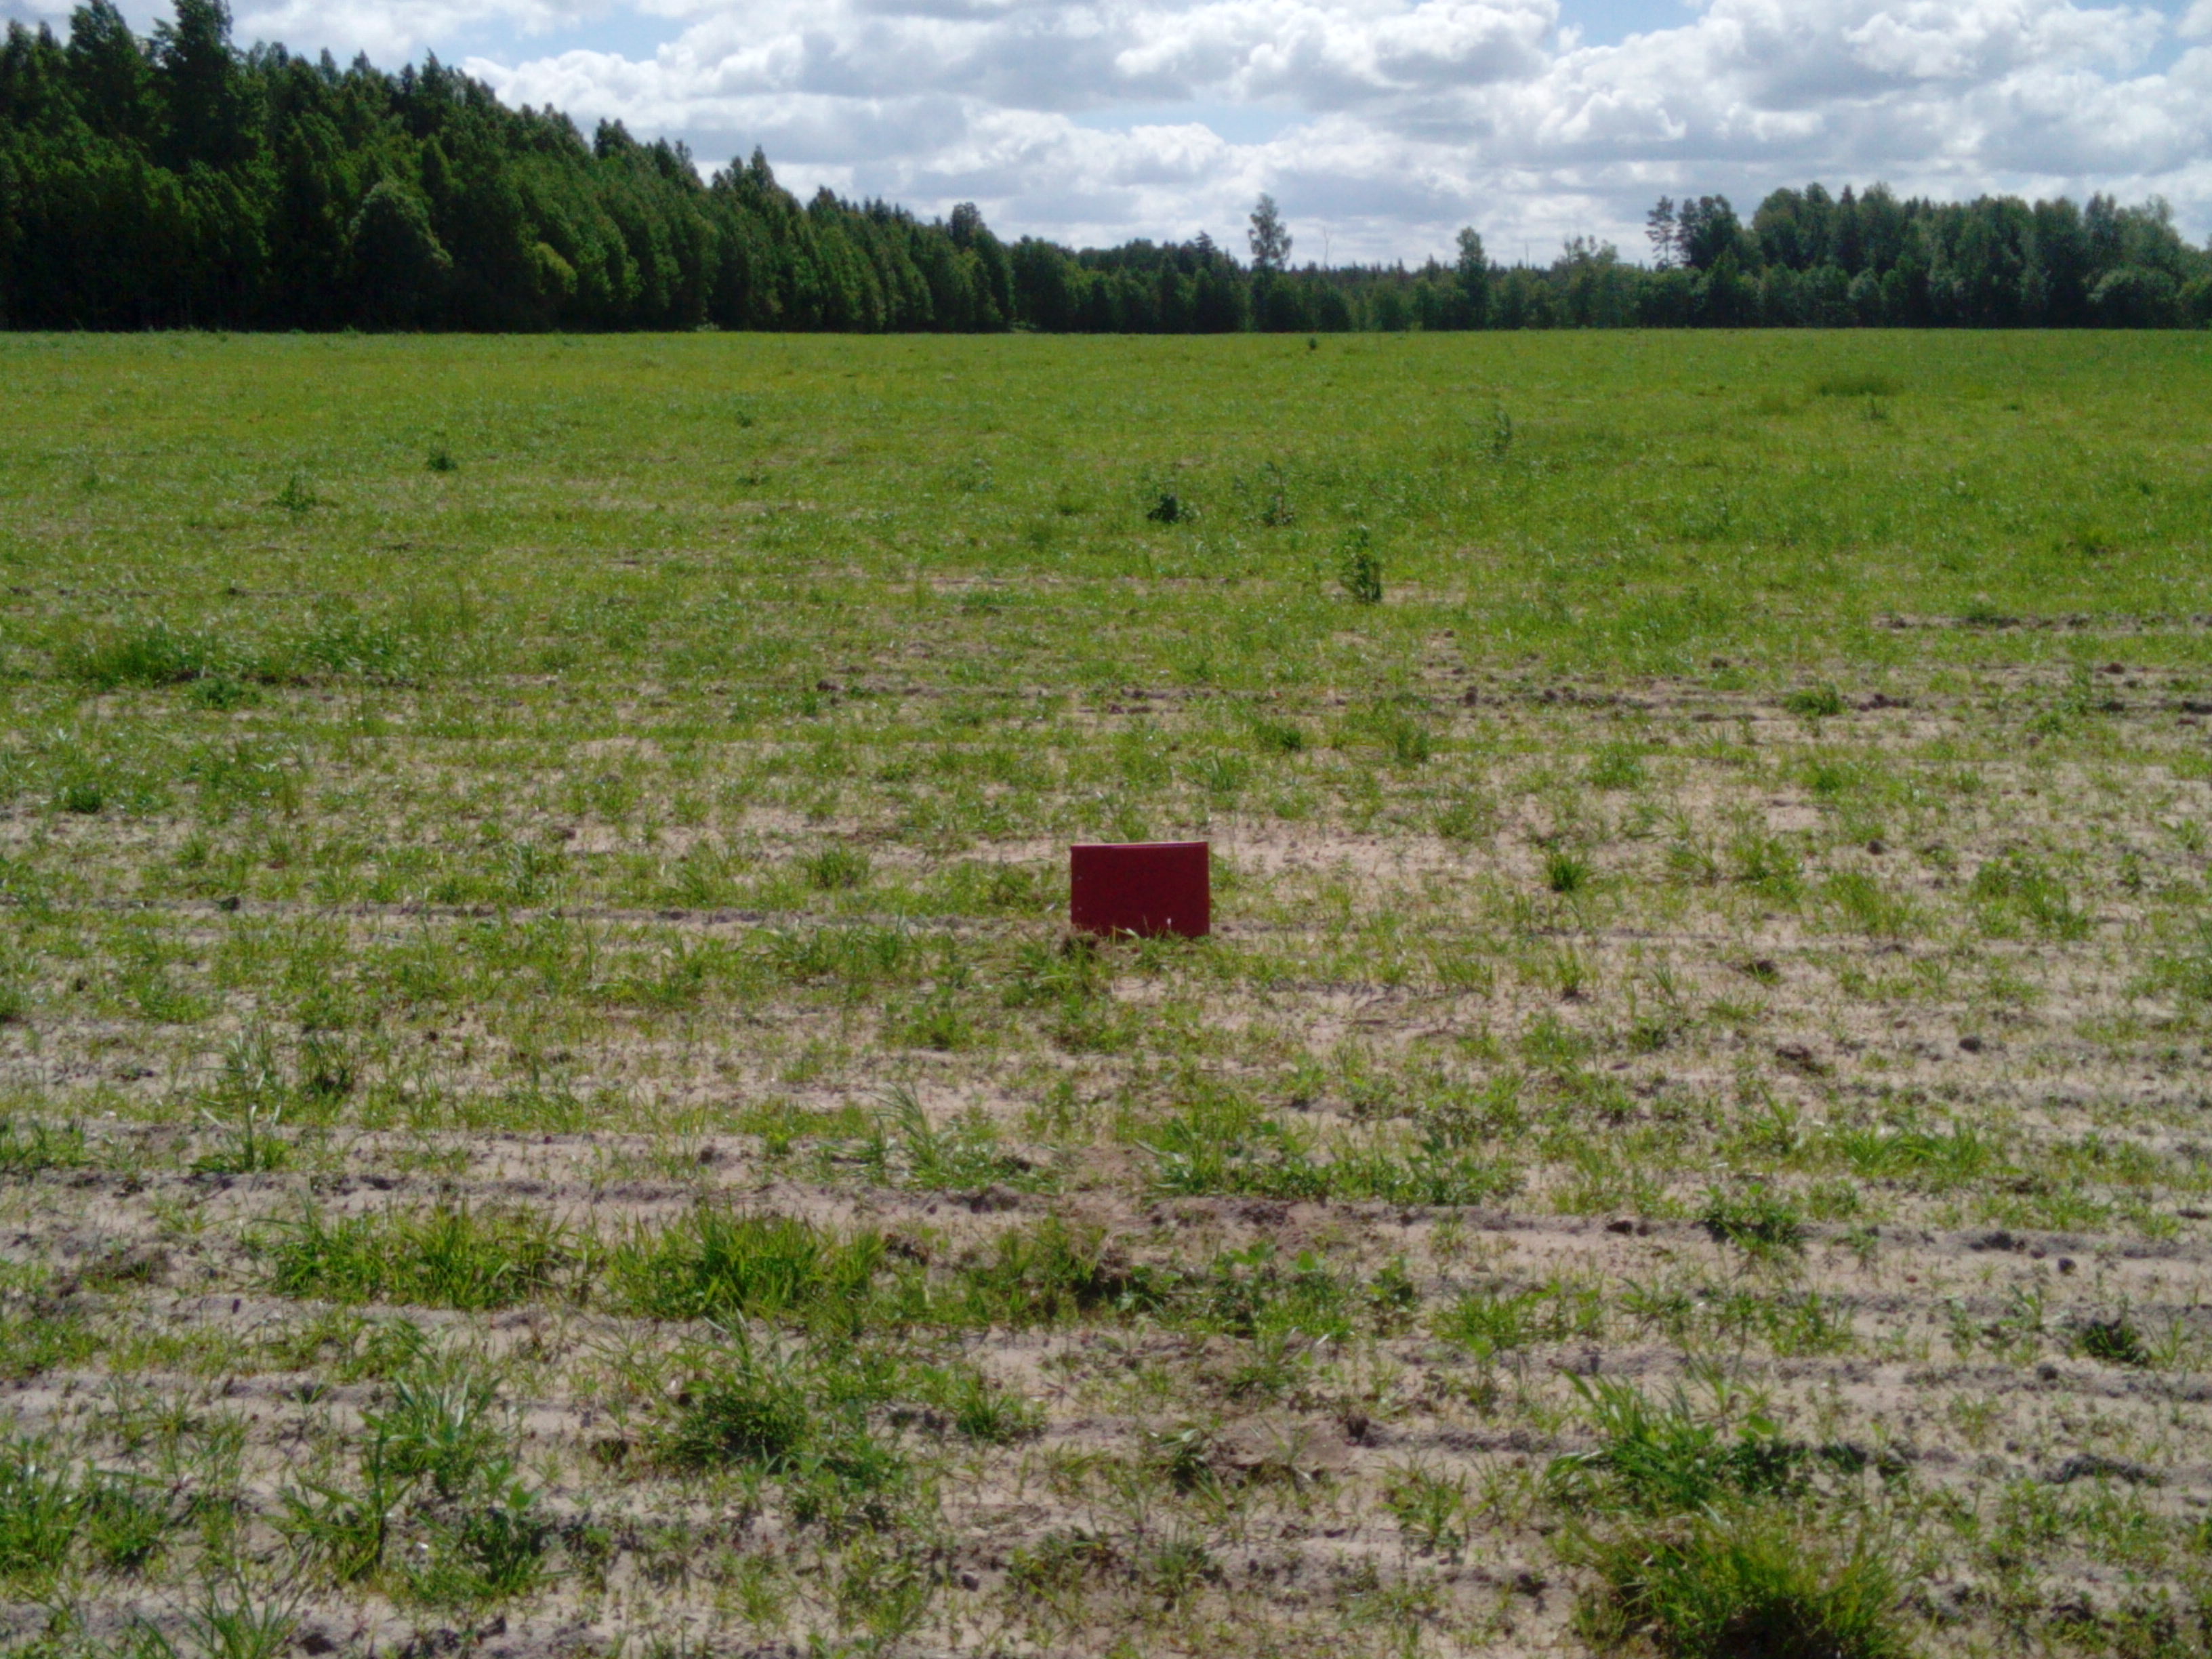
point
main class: Grassland
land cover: Spontaneously vegetated surfaces
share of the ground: 50 - 75 %
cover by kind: herbaceous plants 60 %, unconsolidated bare surface 40 %
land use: Fallow land
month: June
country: LV
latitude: 56.8182
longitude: 22.0576
